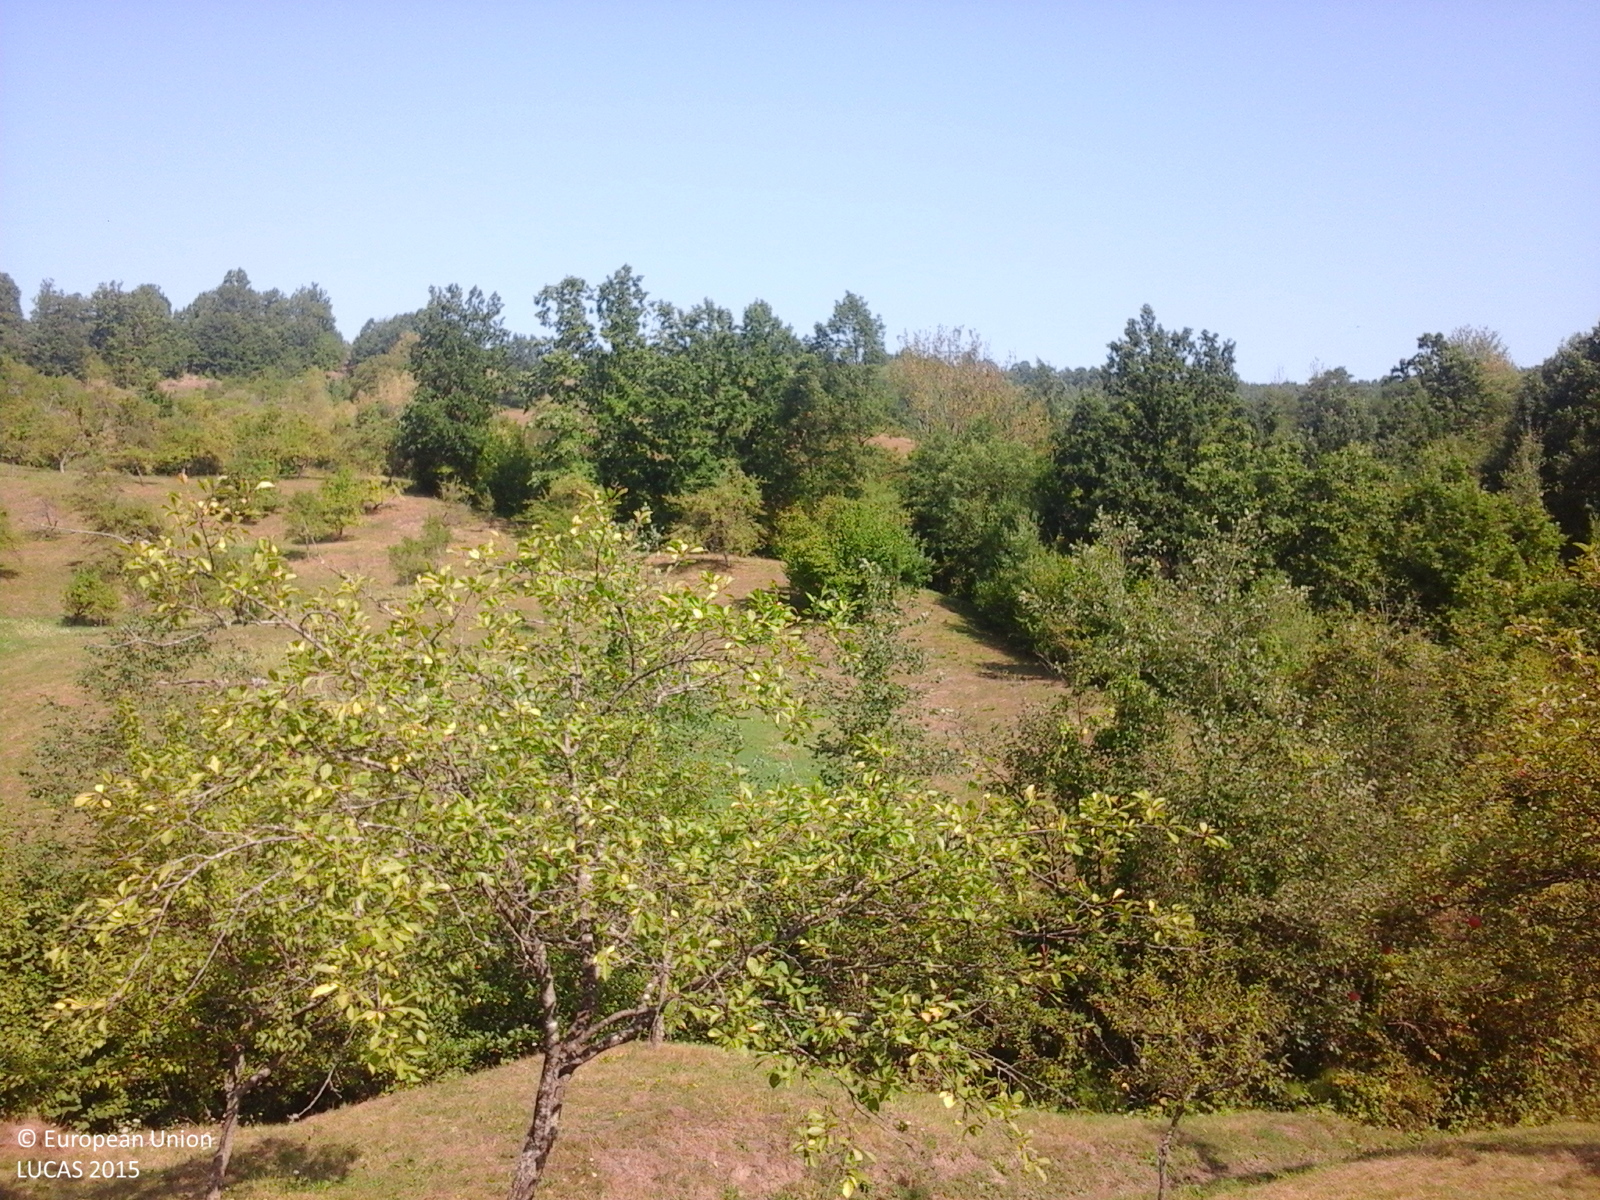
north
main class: Cropland
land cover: Apple fruit
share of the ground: 25 - 50 %
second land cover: Grassland without tree/shrub cover
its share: > 75 %
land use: Agriculture (excluding fallow land and kitchen gardens)
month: September
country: RO
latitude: 47.7952
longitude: 24.1727
